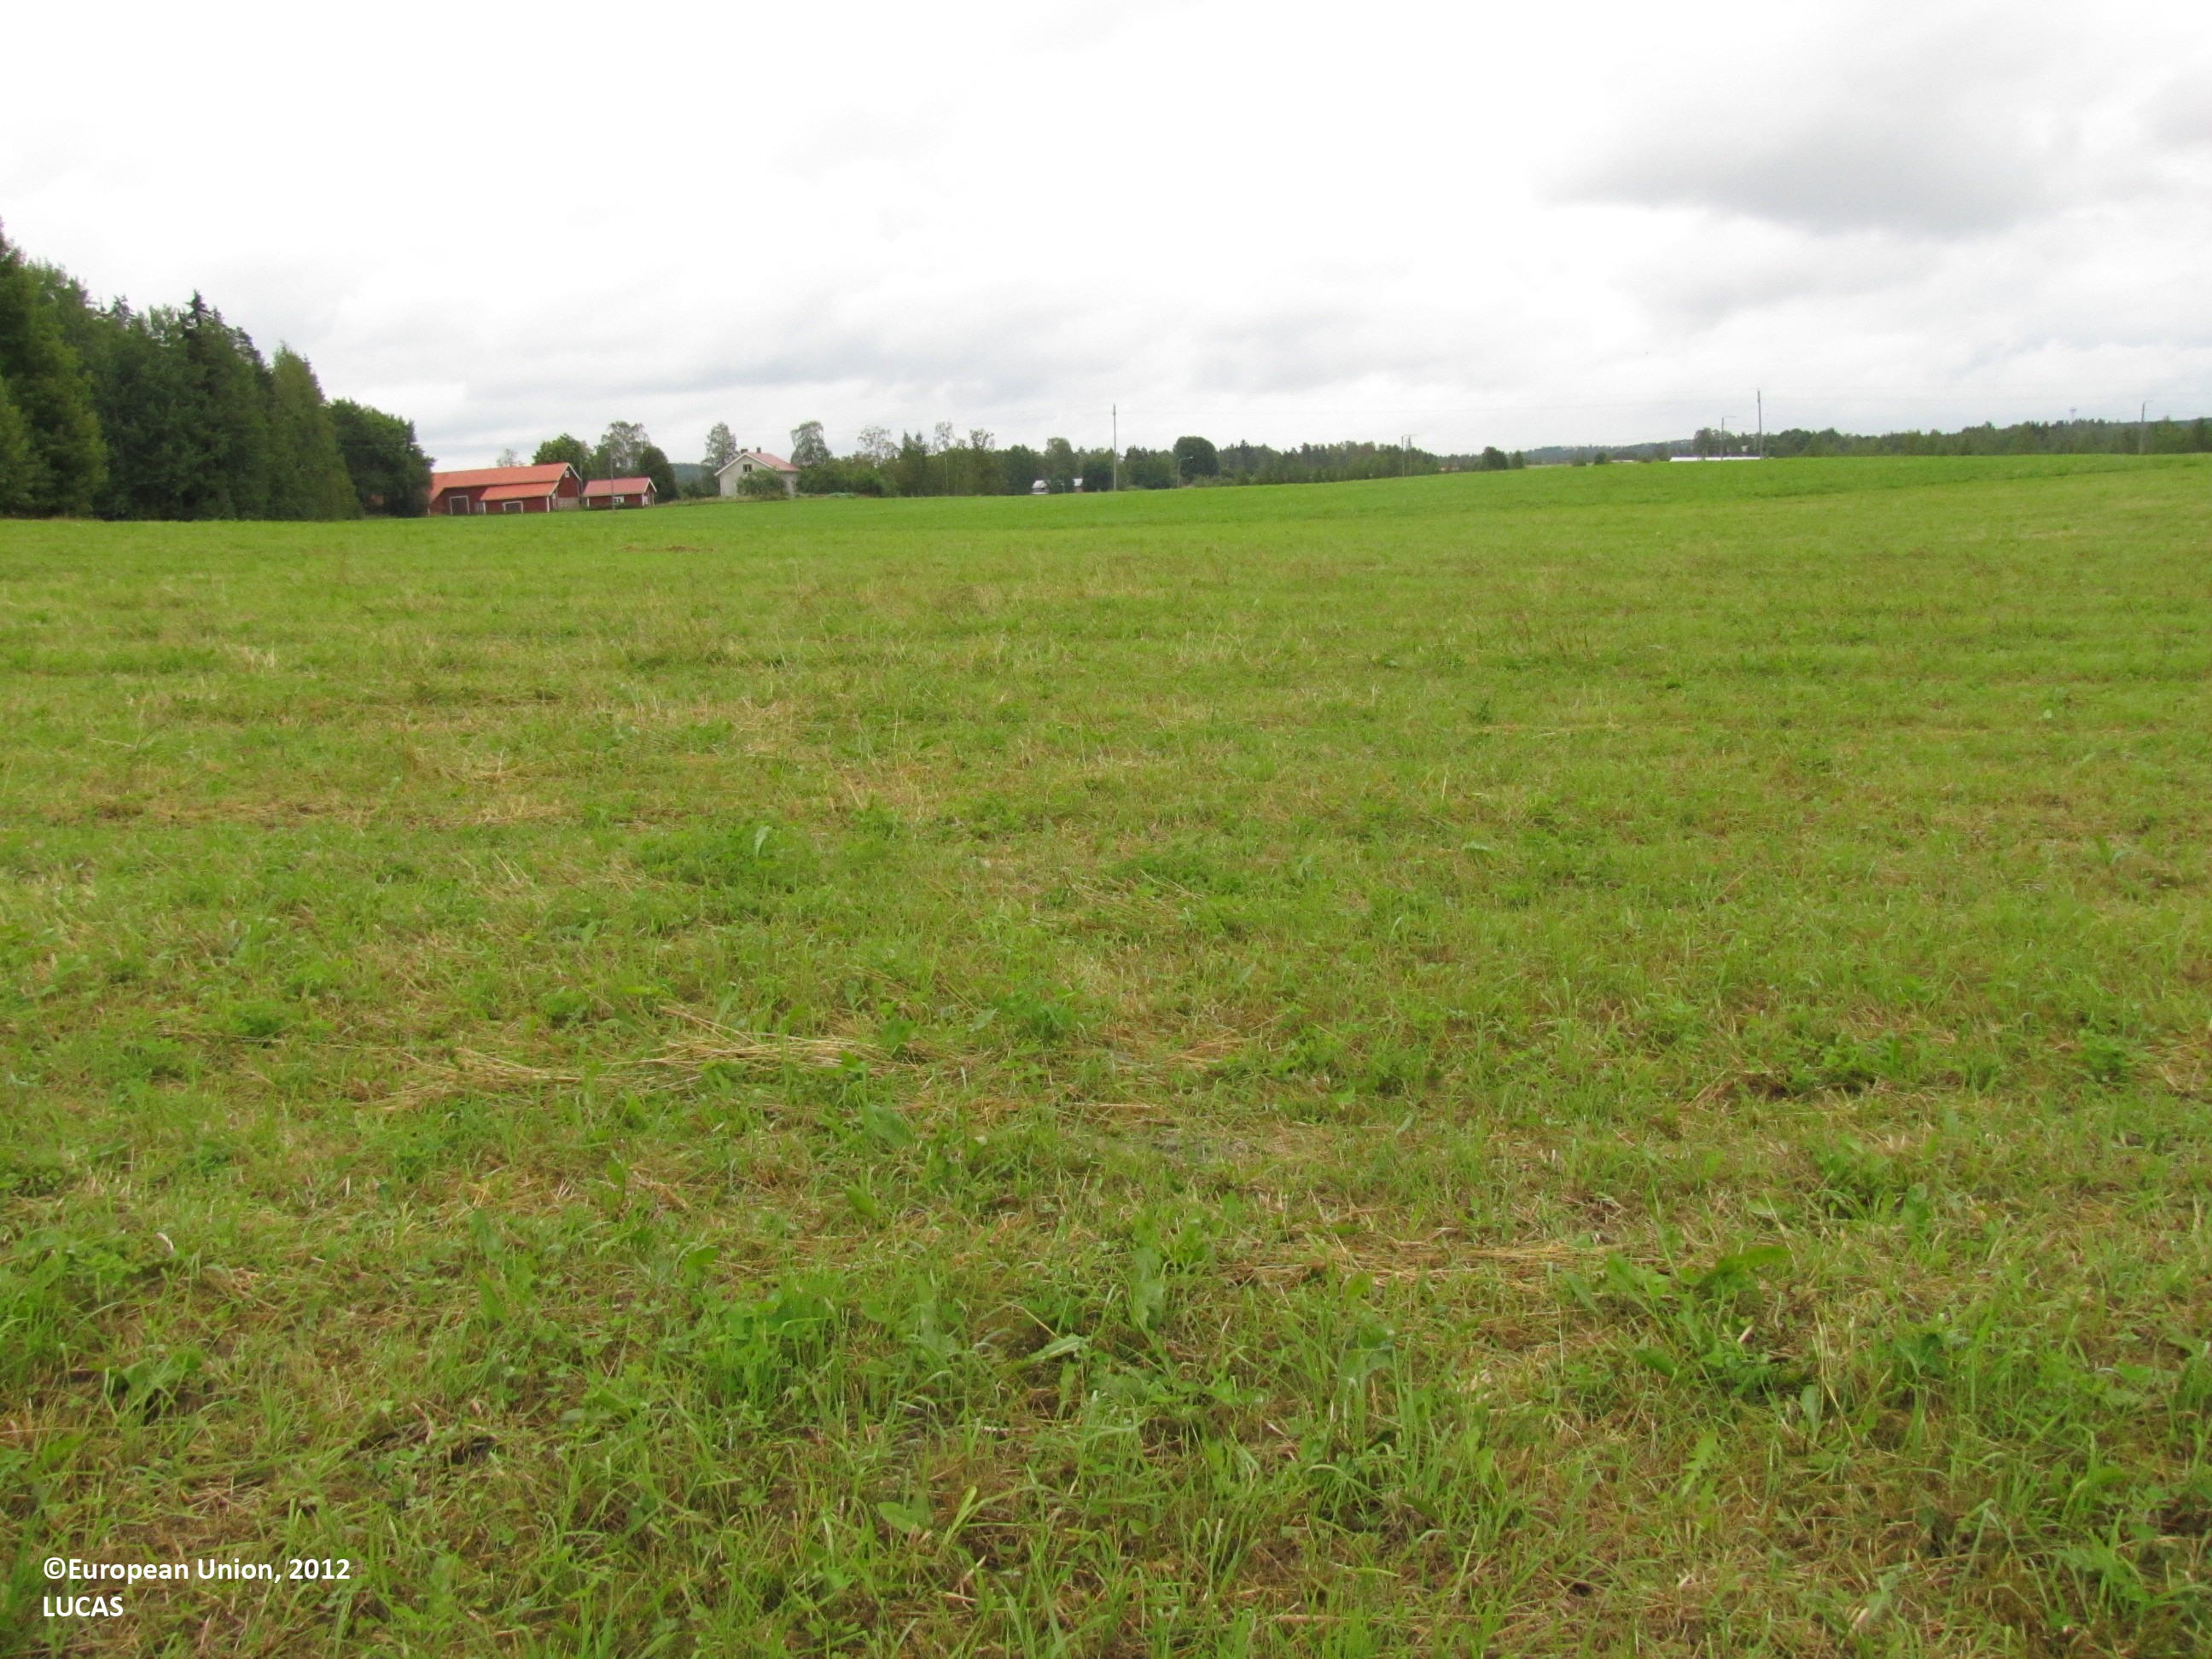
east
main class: Cropland
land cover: Temporary grasslands
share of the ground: > 75 %
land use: Agriculture (excluding fallow land and kitchen gardens)
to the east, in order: Temporary grasslands; Electric lines; Temporary grasslands
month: August
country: FI
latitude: 61.5469
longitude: 23.6473
